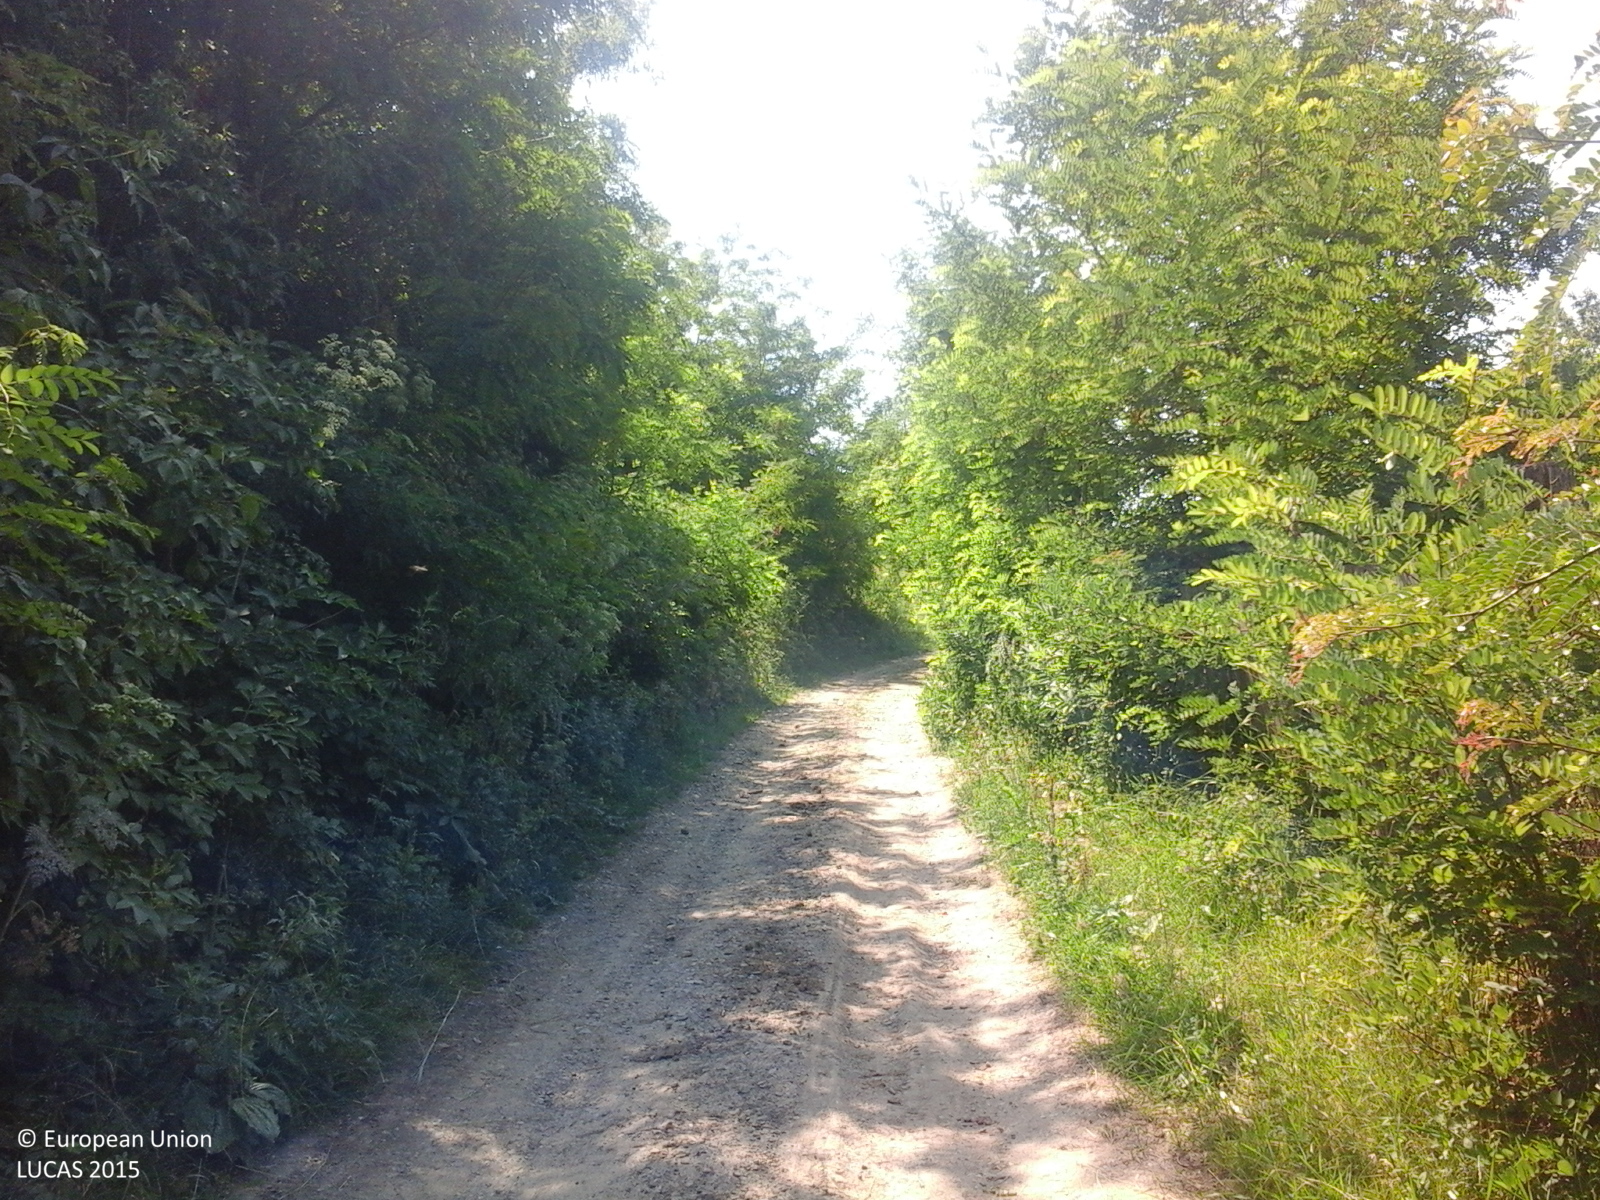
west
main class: Shrubland
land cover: Shrubland with sparse tree cover
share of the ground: > 75 %
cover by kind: shrubs 95 %, broadleaved forest trees 5 %
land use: Semi-natural and natural areas not in use
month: June
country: RO
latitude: 46.7074
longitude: 27.3337
